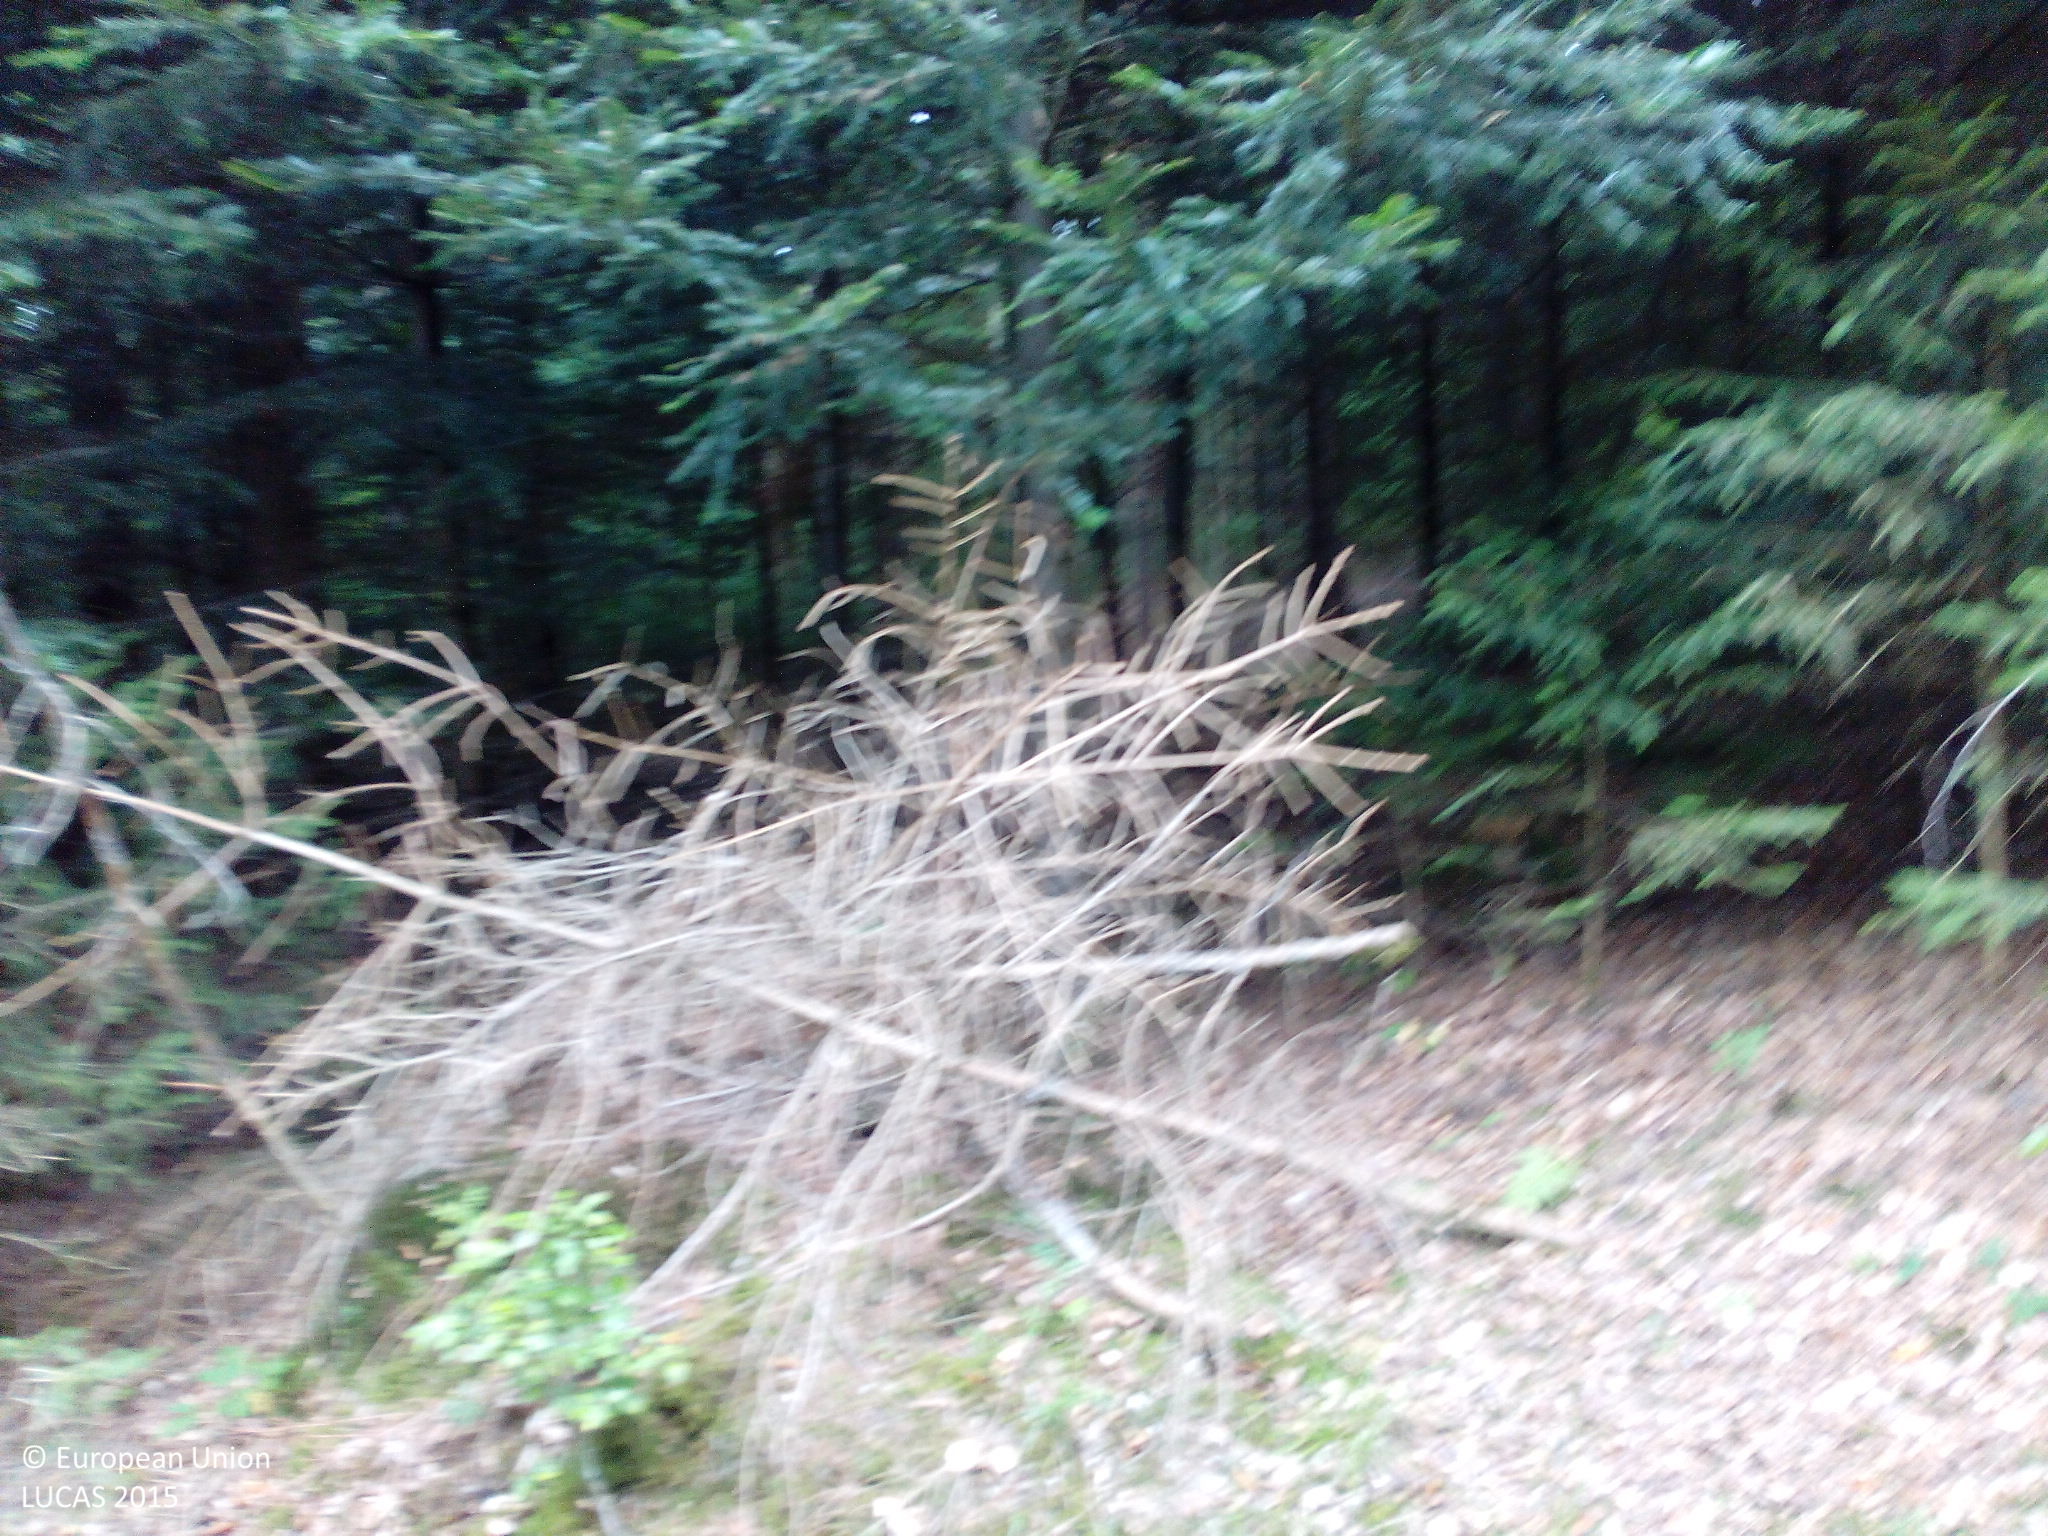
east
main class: Woodland
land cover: Spruce dominated coniferous woodland
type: hemiboreal forest and nemoral coniferous forest and mixed broadleaved-coniferous forest
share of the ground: > 75 %
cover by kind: coniferous forest trees 100 %
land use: Forestry
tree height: > 5 m
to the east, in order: Spruce dominated coniferous woodland; Tracks; Spruce dominated coniferous woodland; Broadleaved woodland
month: September
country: DE
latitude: 48.4836
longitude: 11.4740
